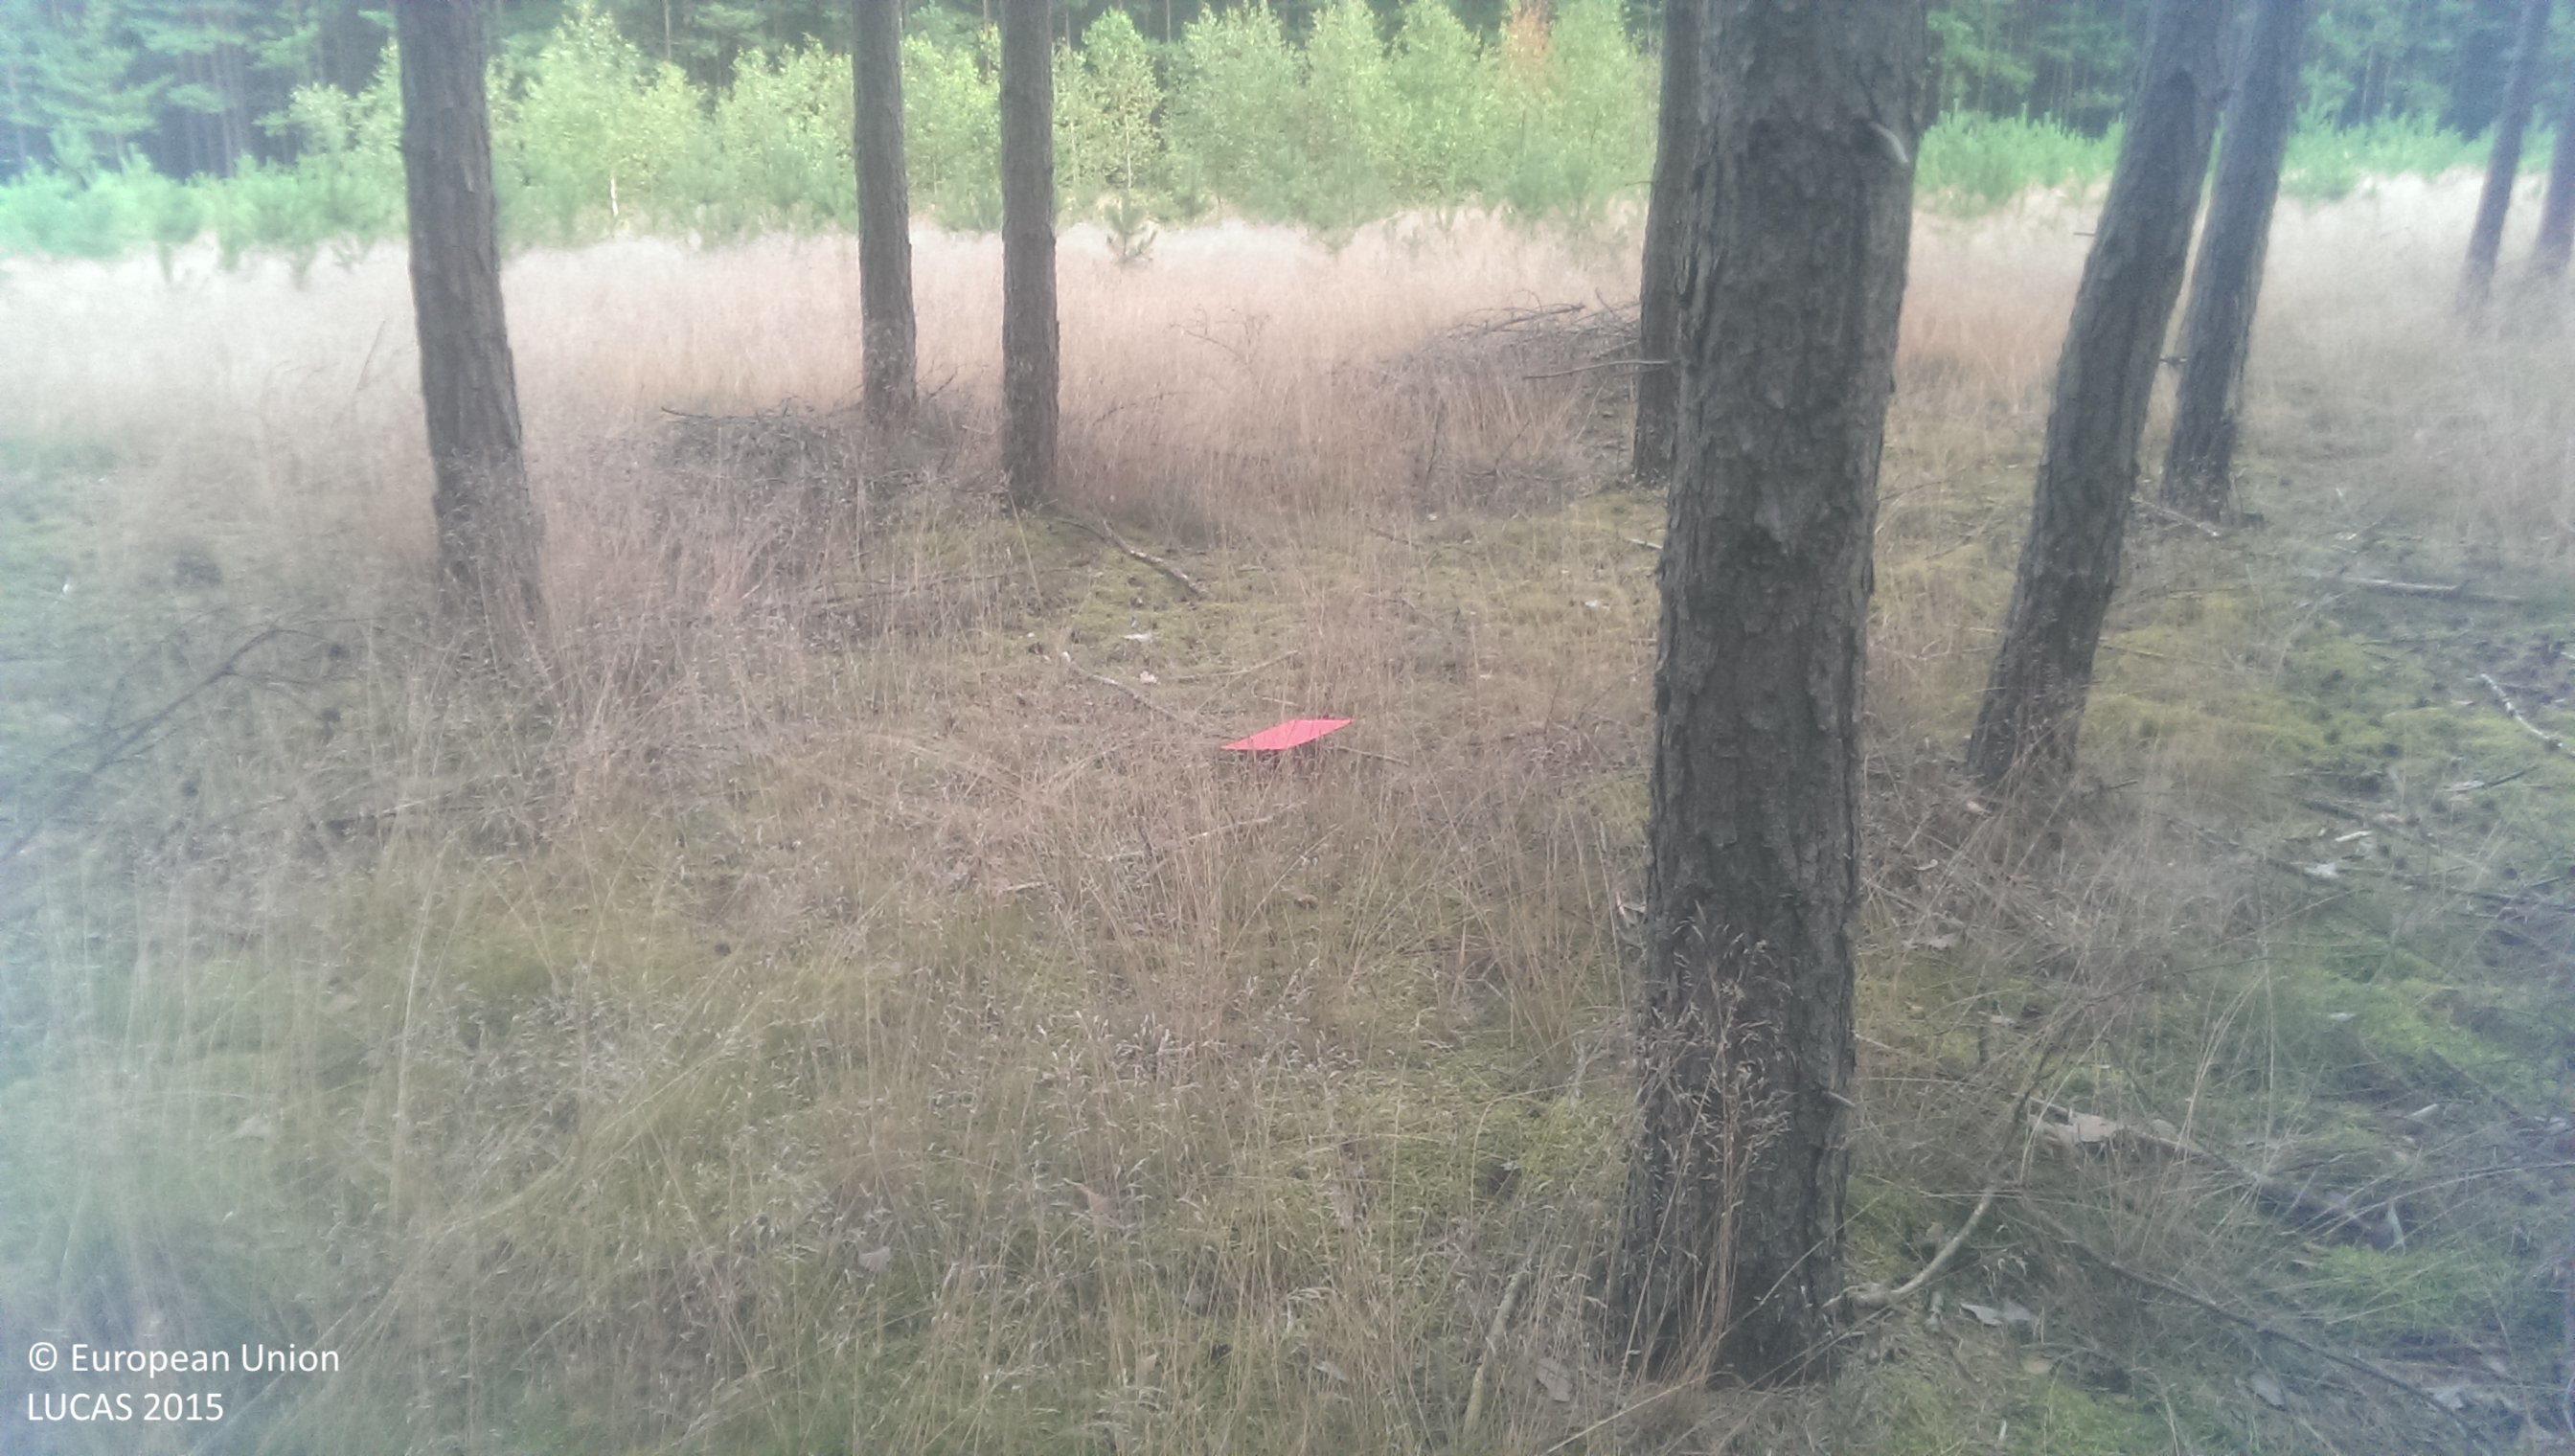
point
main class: Woodland
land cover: Pine dominated coniferous woodland
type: hemiboreal forest and nemoral coniferous forest and mixed broadleaved-coniferous forest
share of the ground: 50 - 75 %
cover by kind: coniferous forest trees 70 %, lichens and mosses 20 %, herbaceous plants 10 %
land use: Forestry
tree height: > 5 m
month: July
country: PL
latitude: 52.3701
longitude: 15.6297
